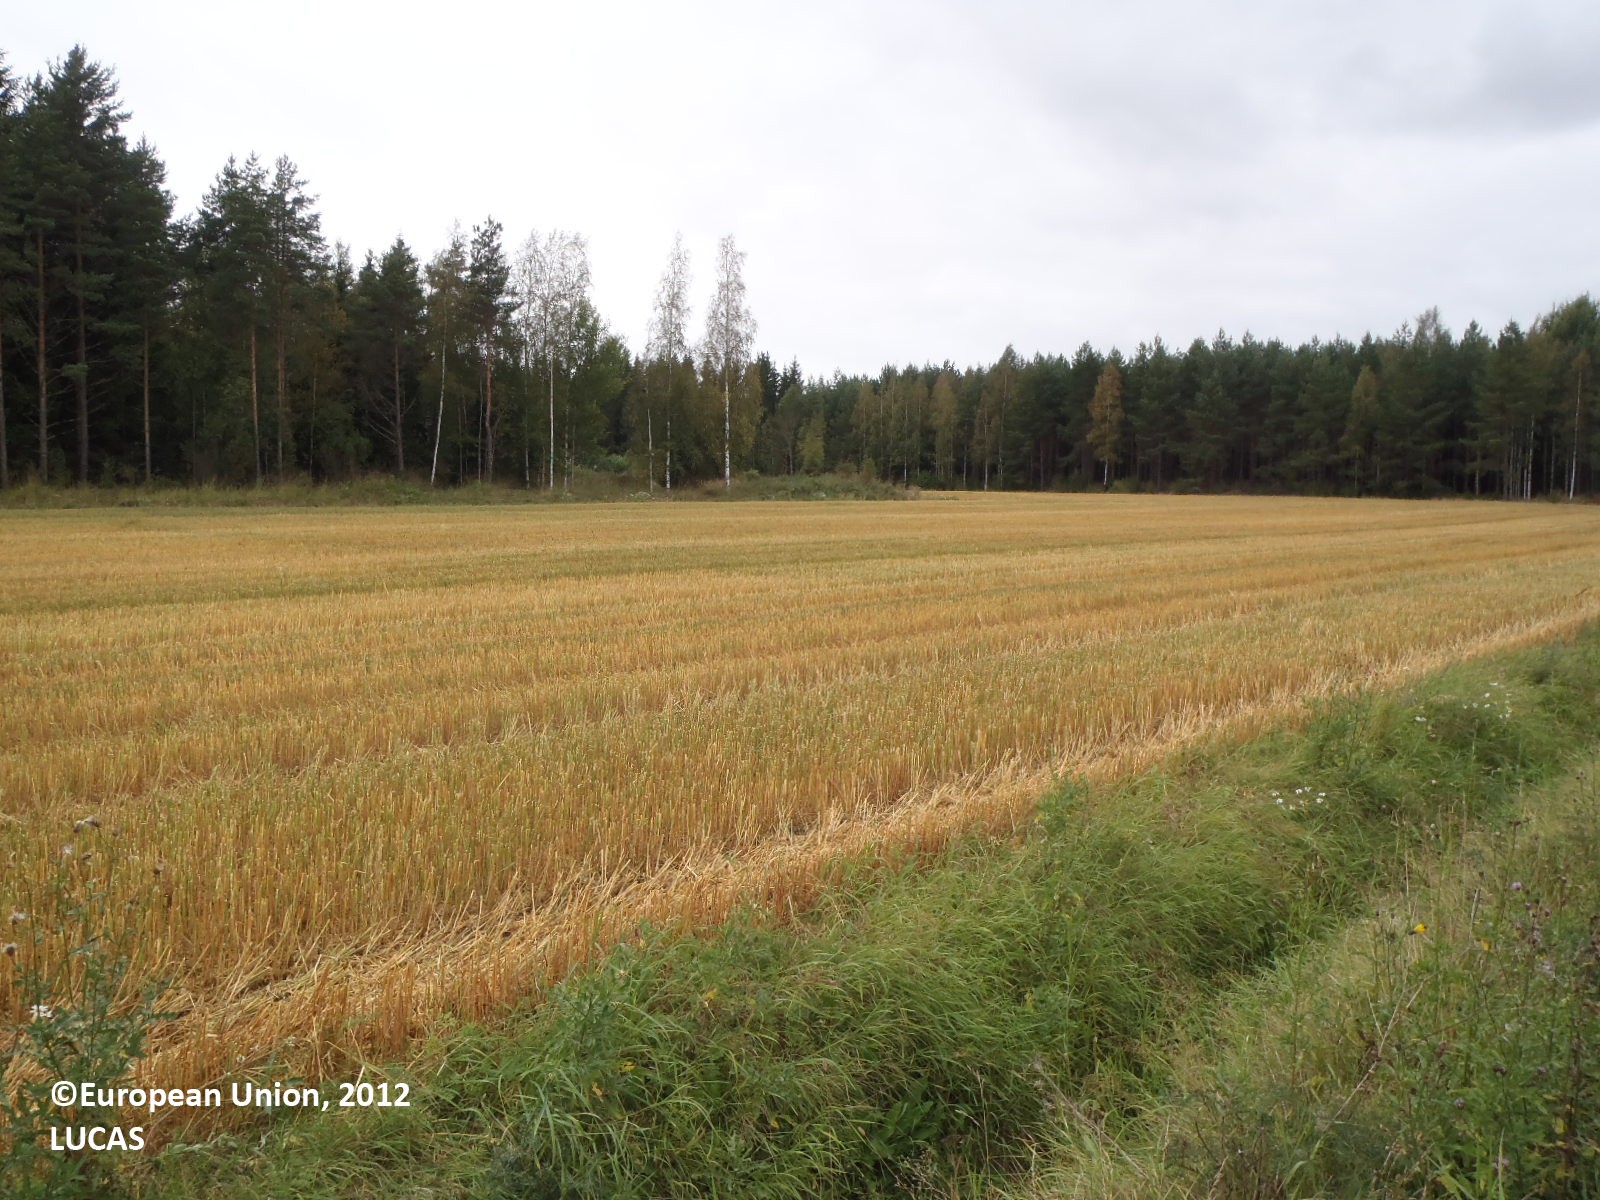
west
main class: Cropland
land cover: Common wheat
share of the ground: > 75 %
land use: Agriculture (excluding fallow land and kitchen gardens)
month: September
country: FI
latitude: 60.9447
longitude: 22.8273
